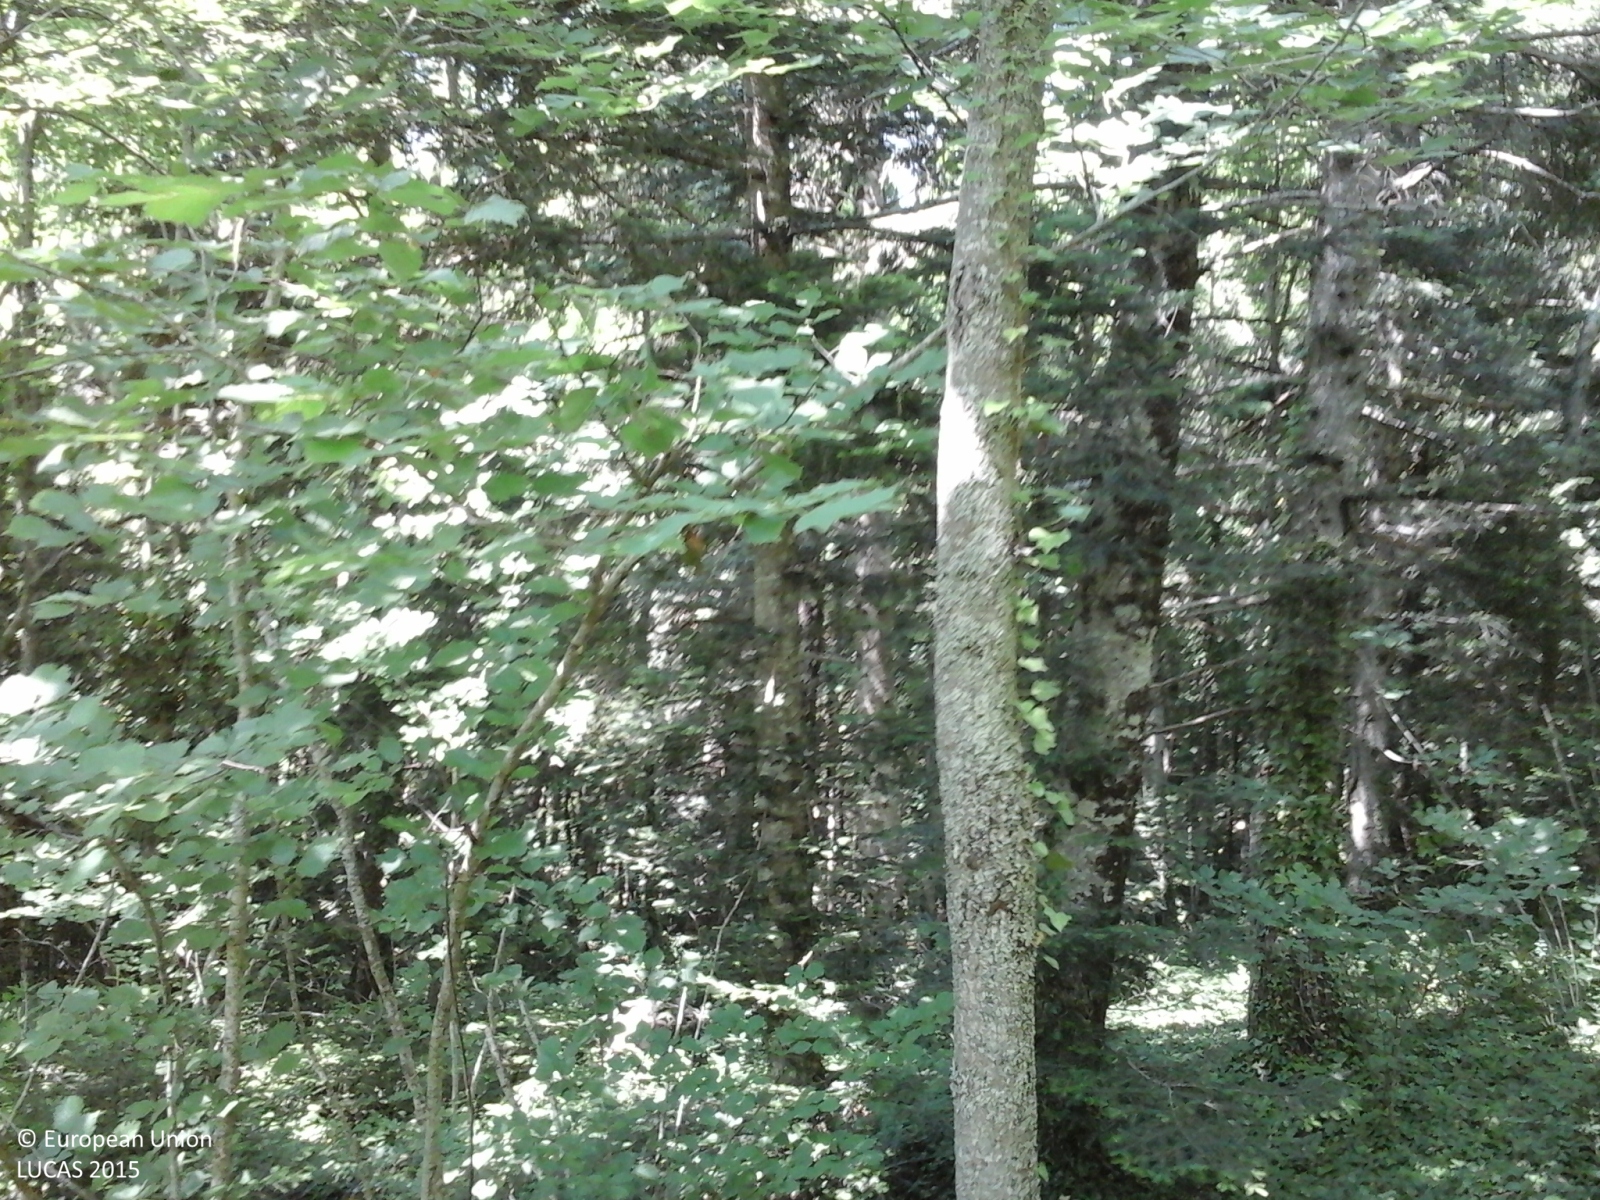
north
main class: Woodland
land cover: Other mixed woodland
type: hemiboreal forest and nemoral coniferous forest and mixed broadleaved-coniferous forest
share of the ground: > 75 %
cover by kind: coniferous forest trees 40 %, broadleaved forest trees 40 %, shrubs 10 %, herbaceous plants 5 %, lichens and mosses 5 %
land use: Forestry
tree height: > 5 m
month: June
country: IT
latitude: 41.8929
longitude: 14.3125
